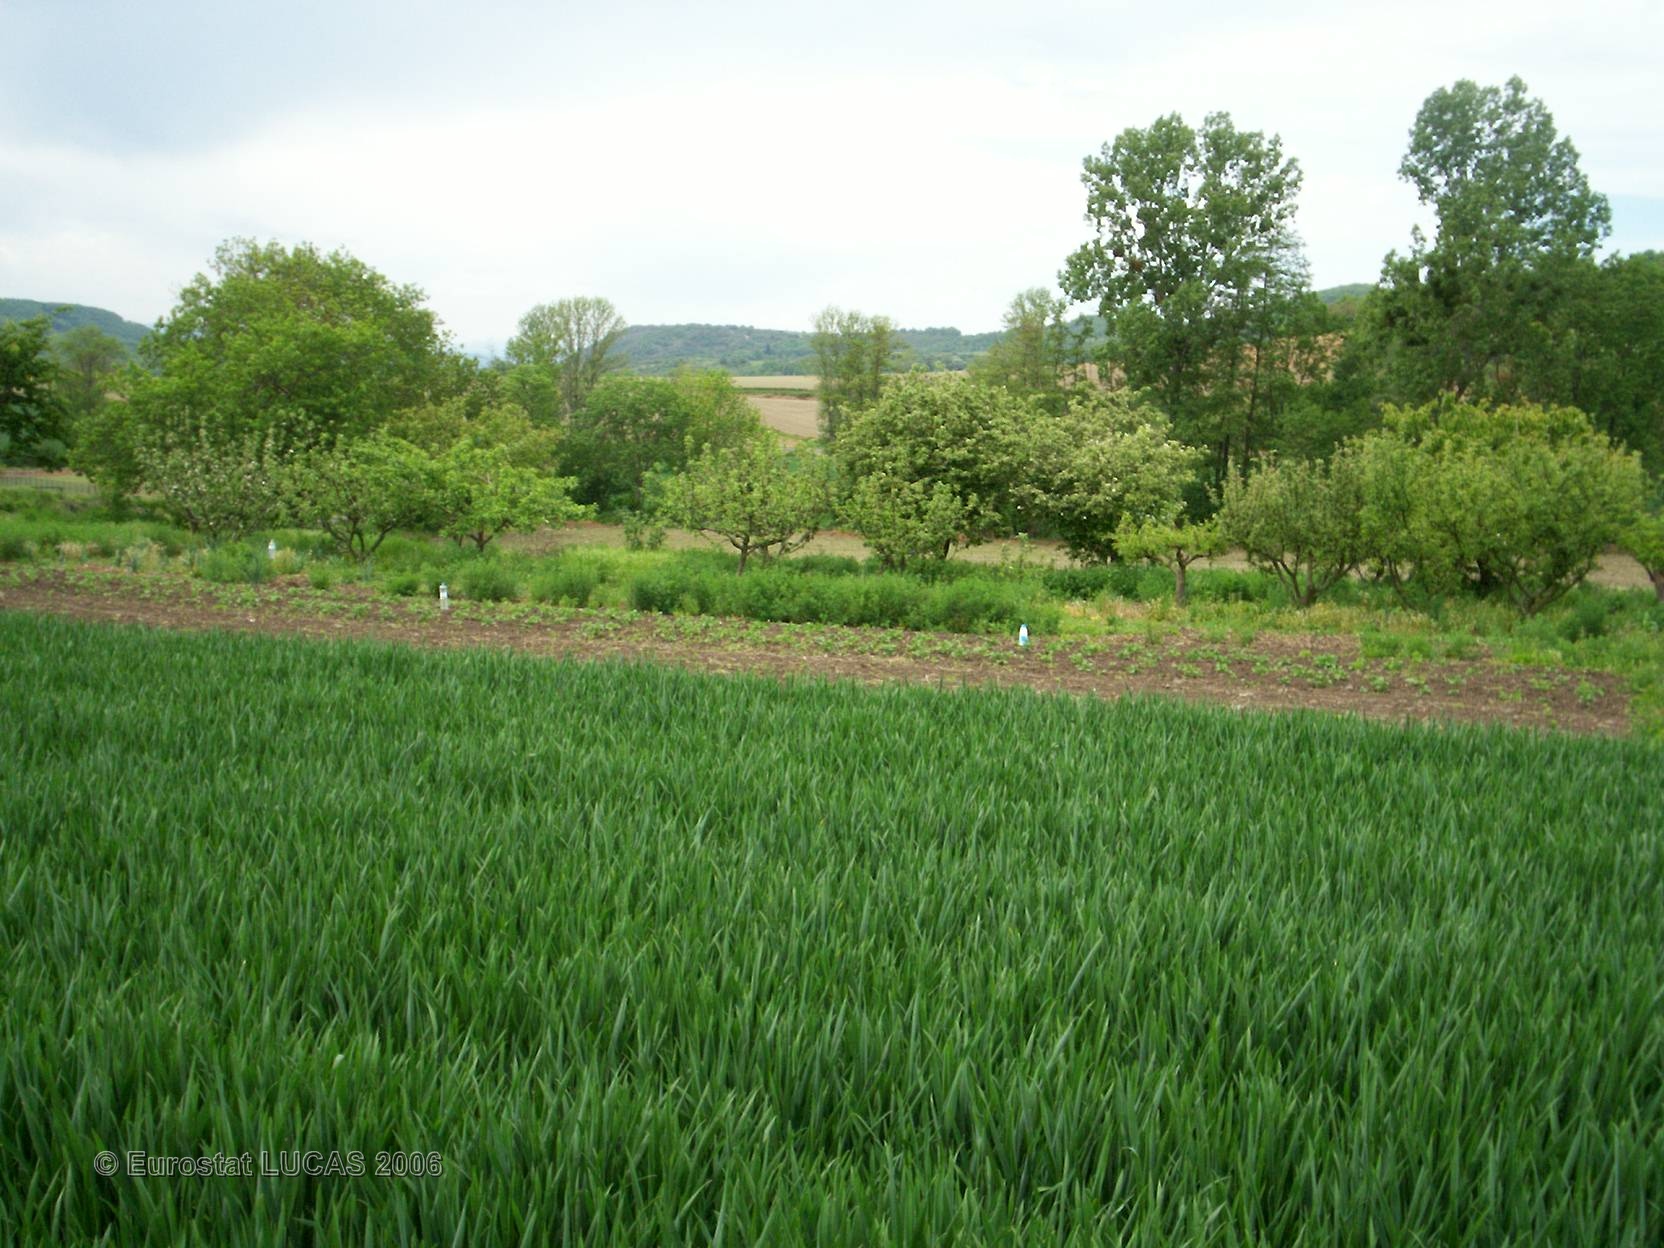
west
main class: Cropland
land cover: Common wheat
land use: Agriculture (excluding fallow land and kitchen gardens)
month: May
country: FR
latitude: 45.5986
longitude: 3.2961
